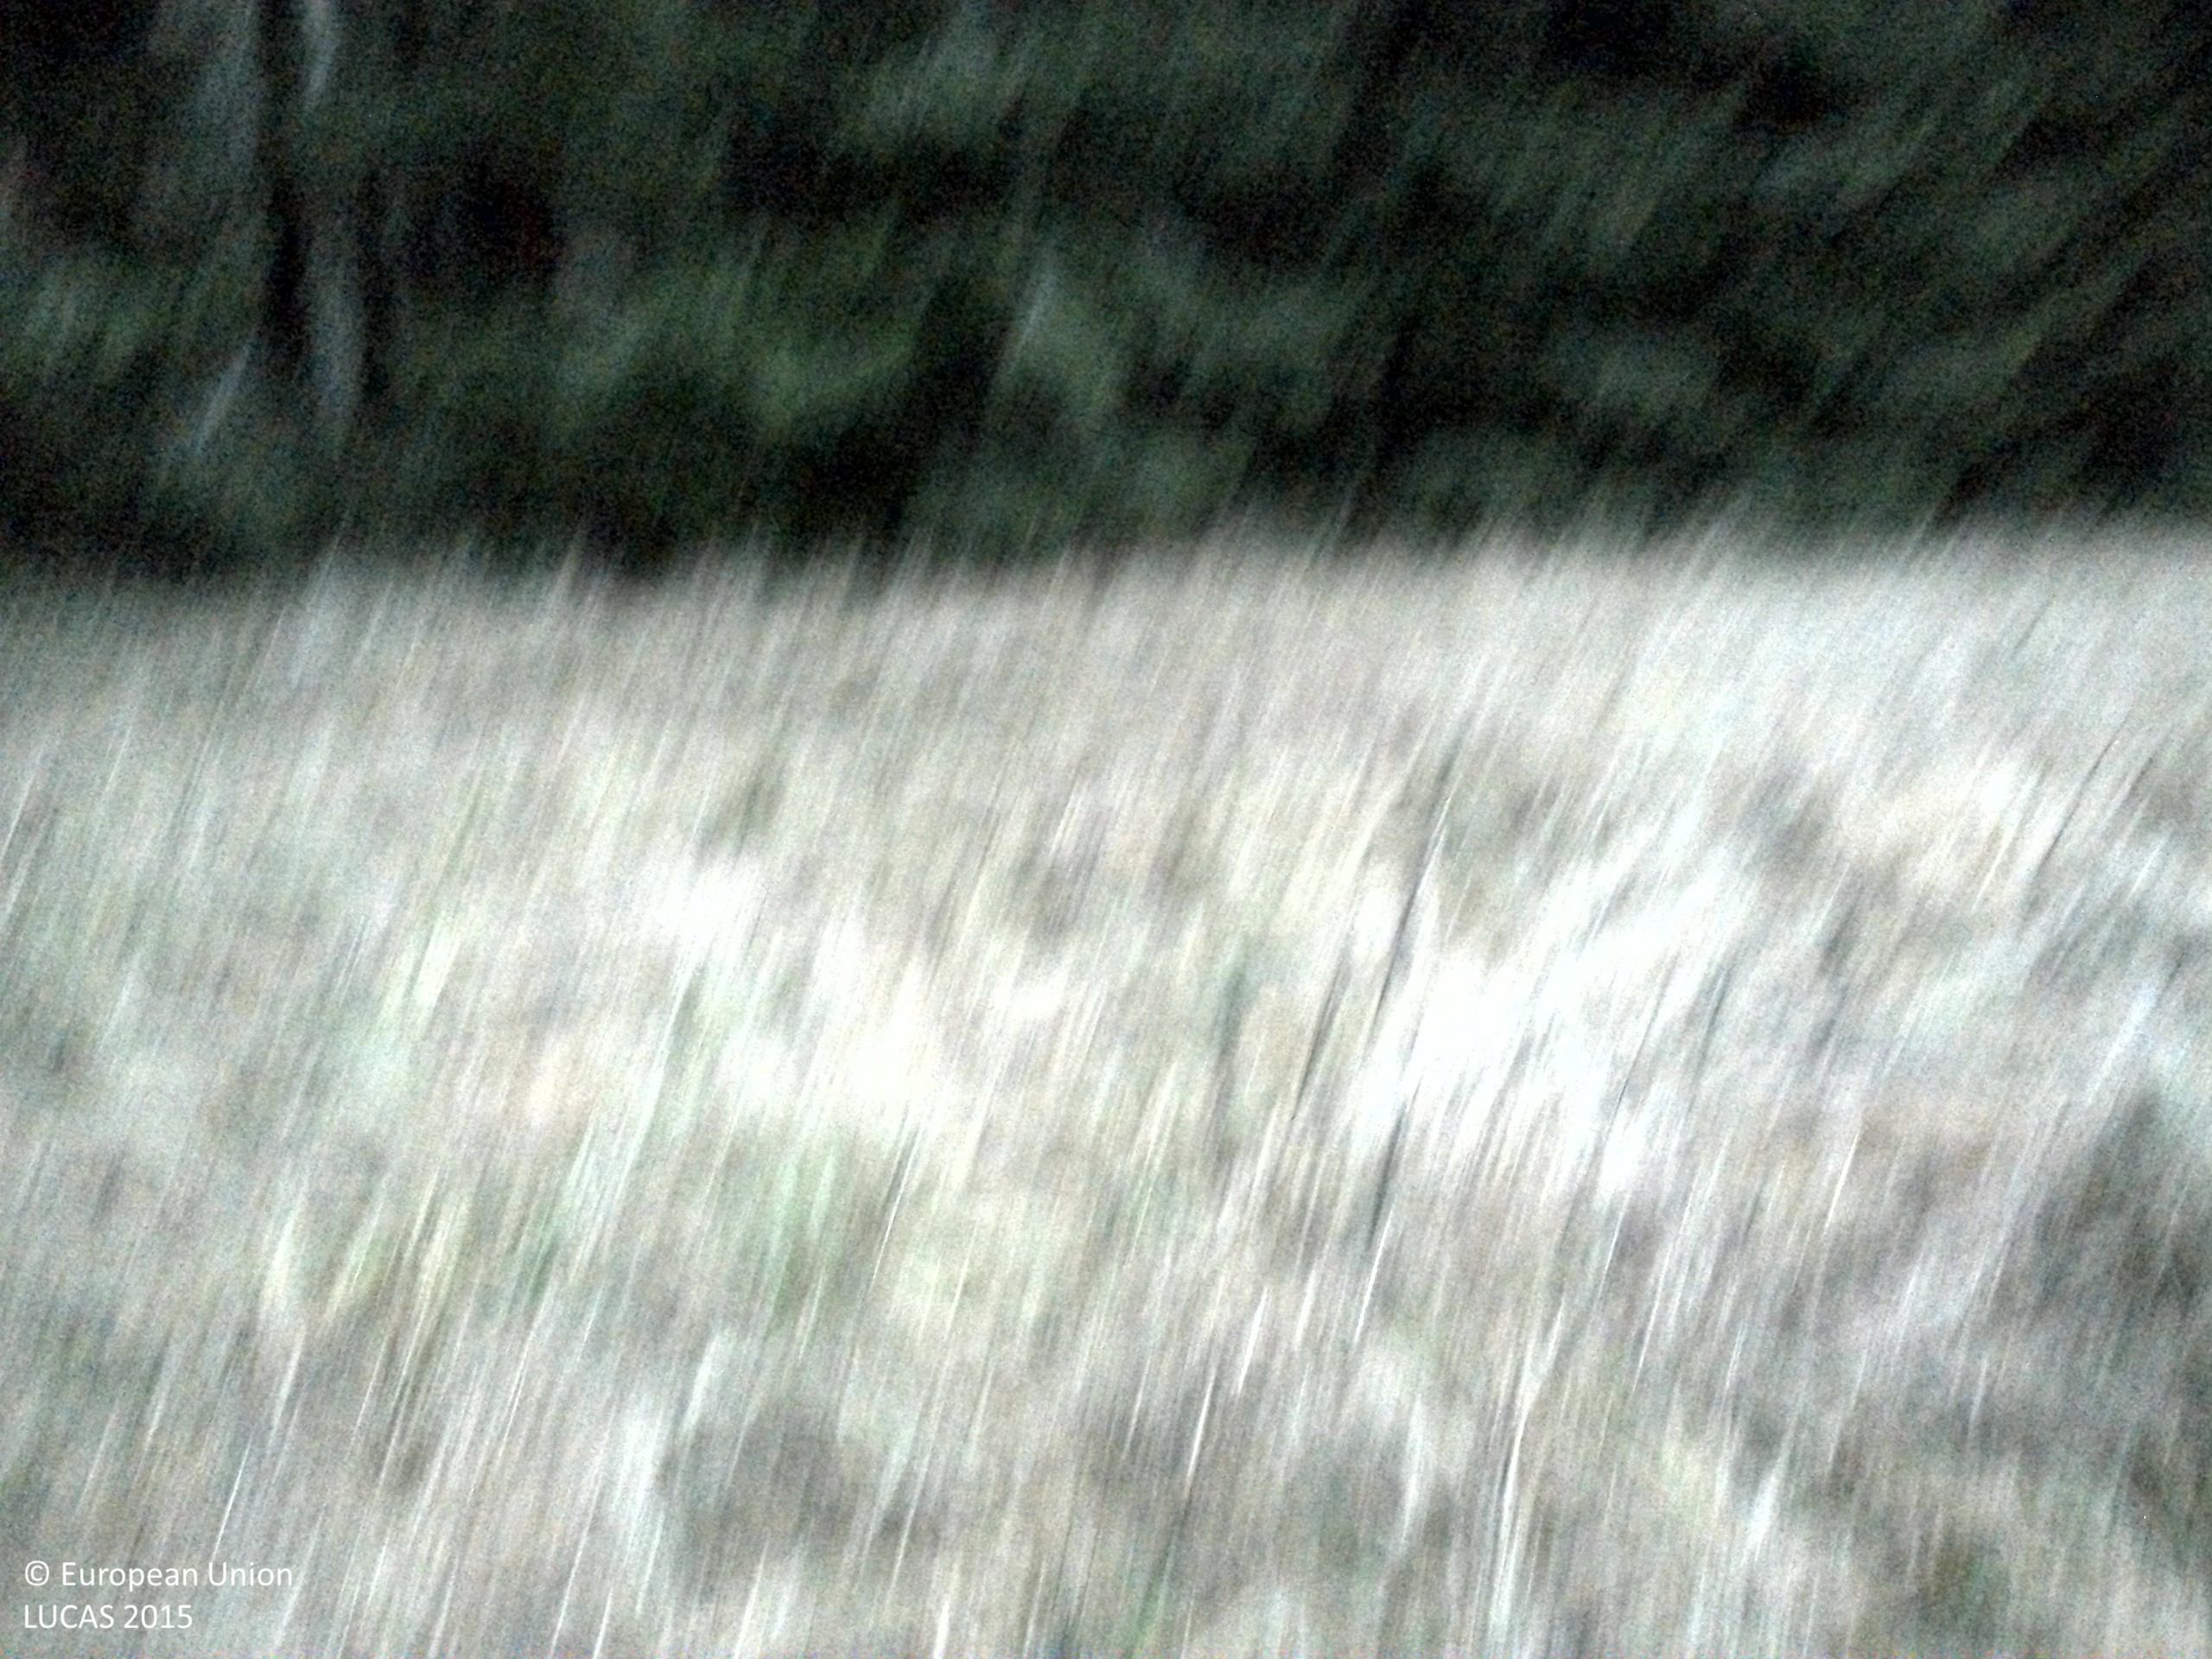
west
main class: Grassland
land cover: Grassland without tree/shrub cover
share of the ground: > 75 %
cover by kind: herbaceous plants 95 %, consolidated bare surface 5 %
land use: Other primary production
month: November
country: SE
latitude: 58.8222
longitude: 16.8366
